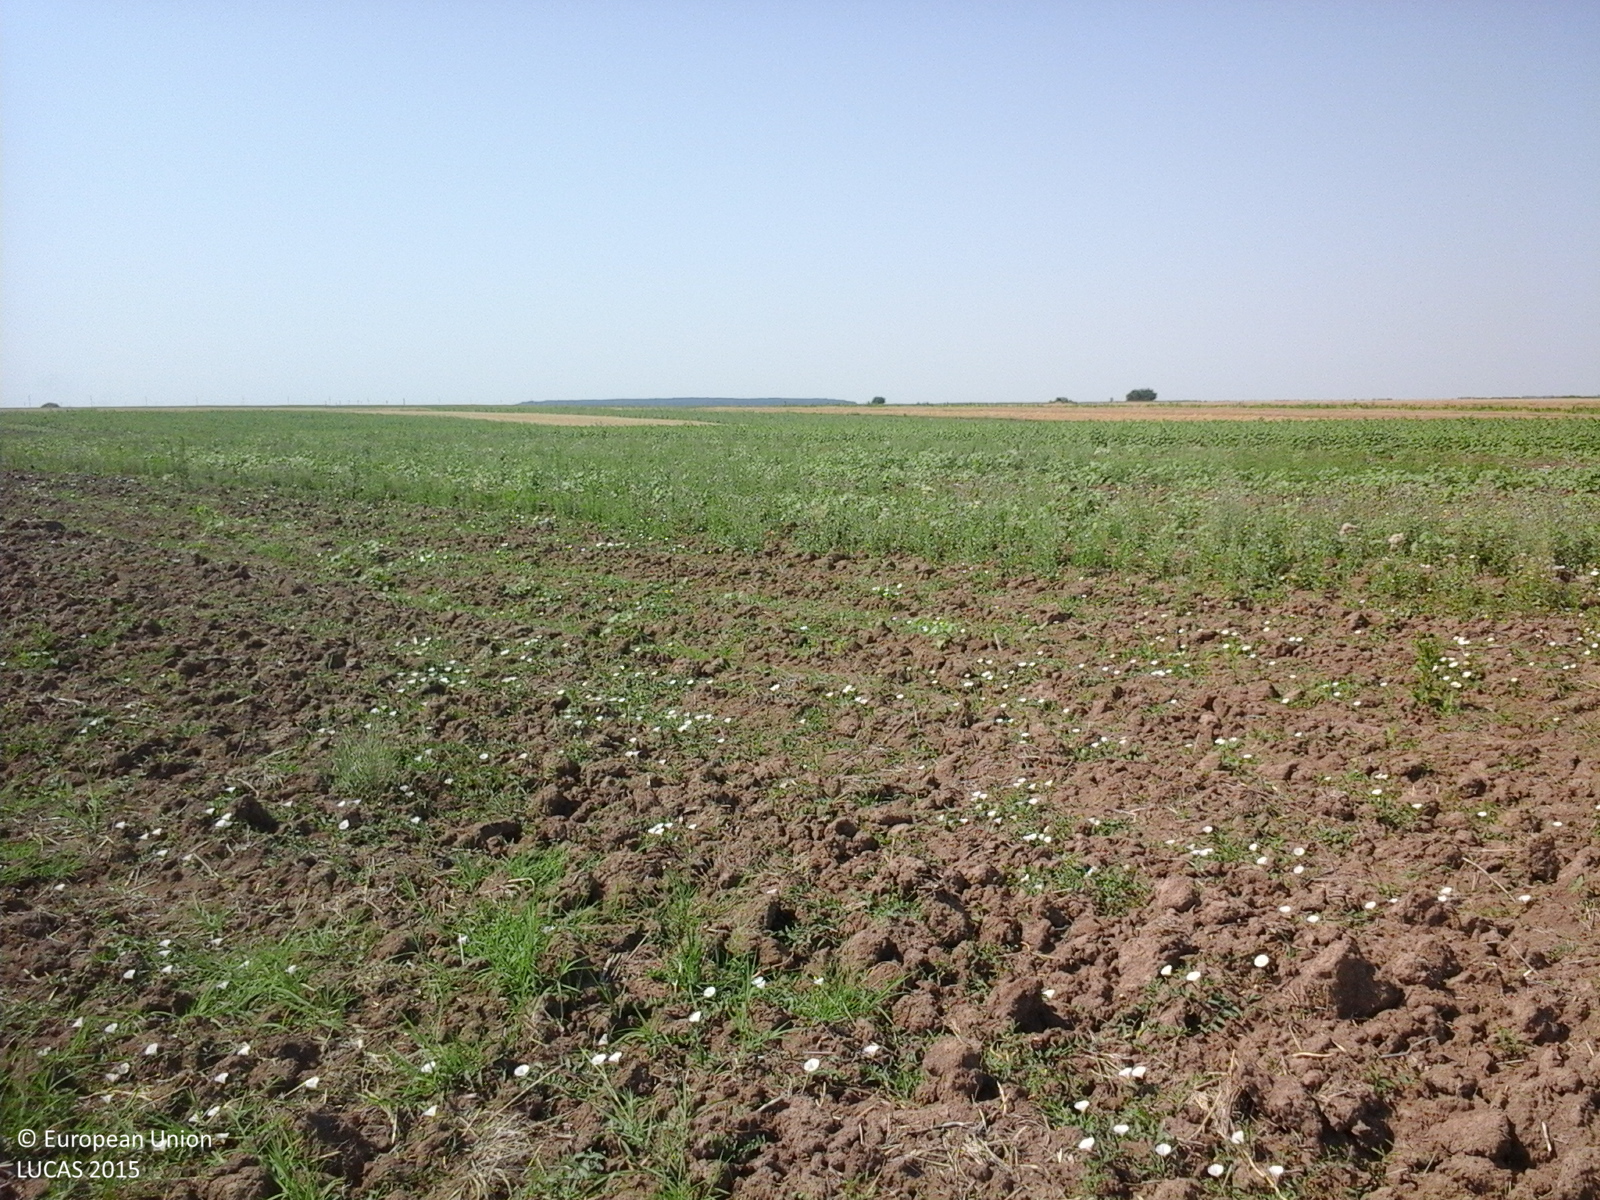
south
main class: Cropland
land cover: Durum wheat
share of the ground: < 10 %
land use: Agriculture (excluding fallow land and kitchen gardens)
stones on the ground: < 10 %
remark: Harvested field
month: July
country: RO
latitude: 44.4183
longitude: 25.2960
